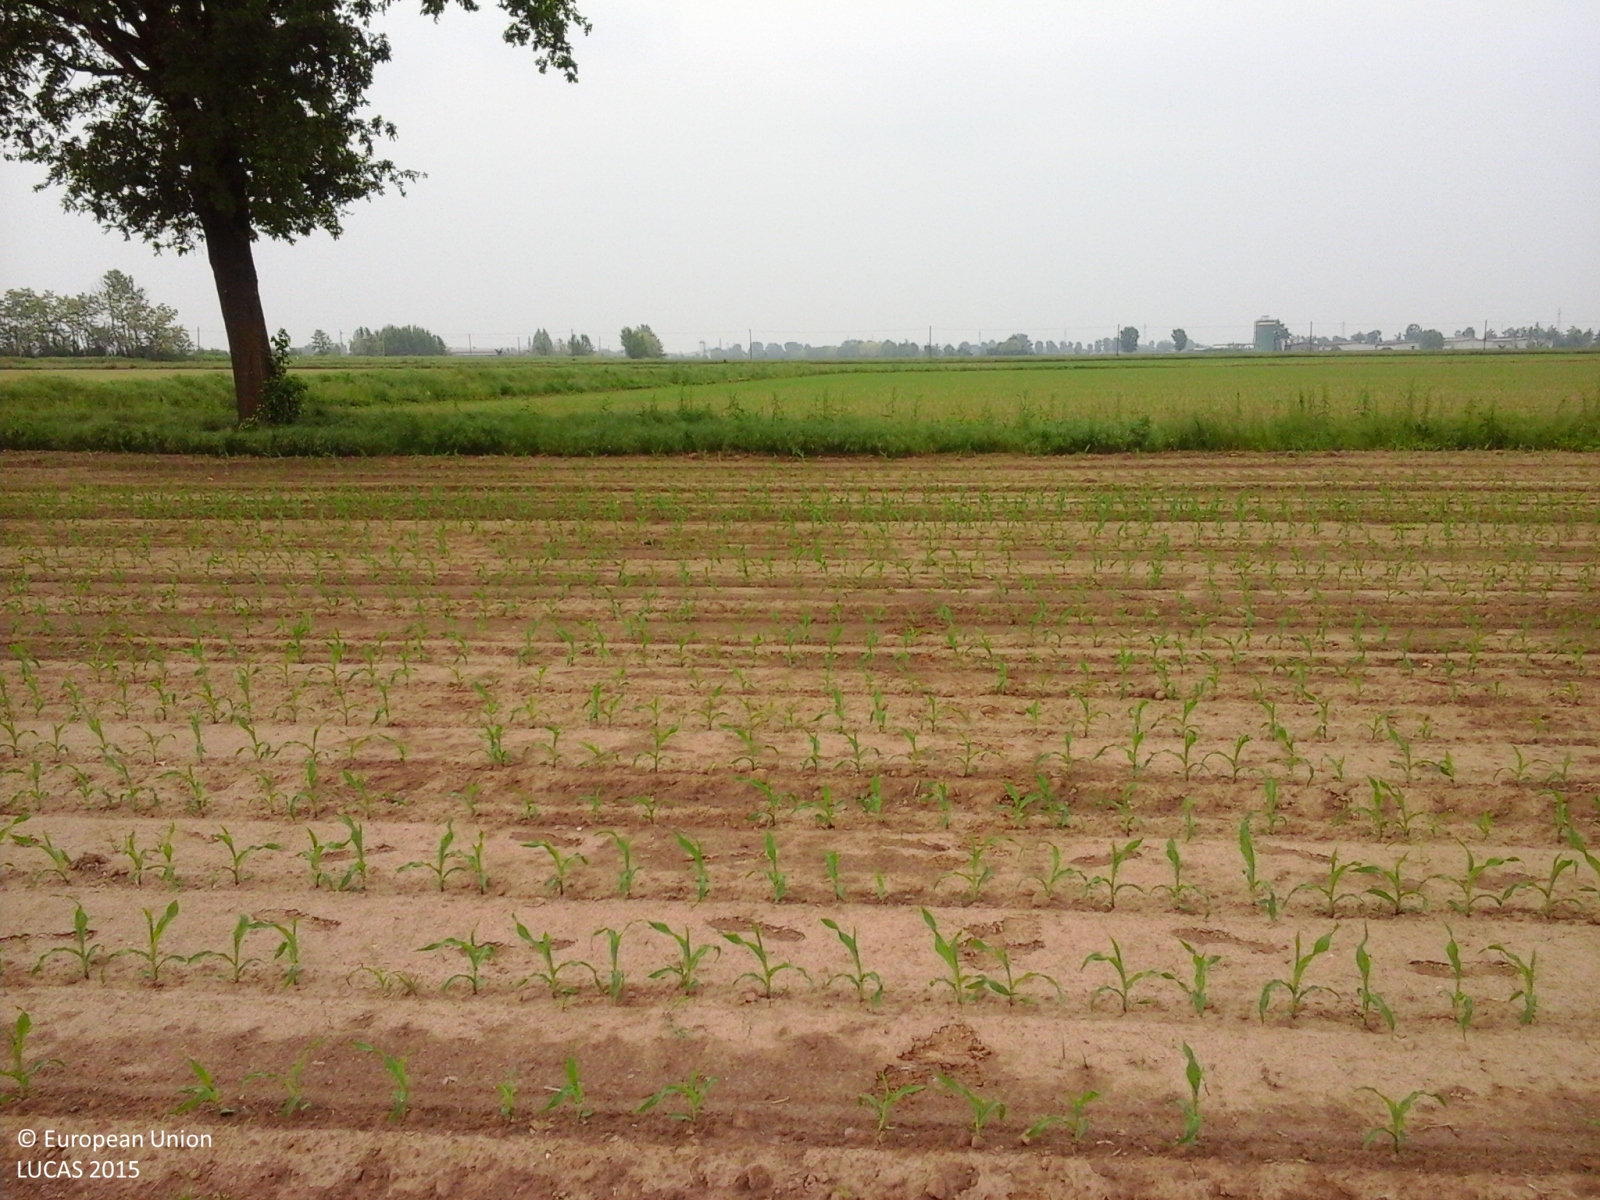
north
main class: Cropland
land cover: Maize
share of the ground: 10 - 25 %
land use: Agriculture (excluding fallow land and kitchen gardens)
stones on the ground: < 10 %
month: May
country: IT
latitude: 45.2160
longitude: 9.9619
